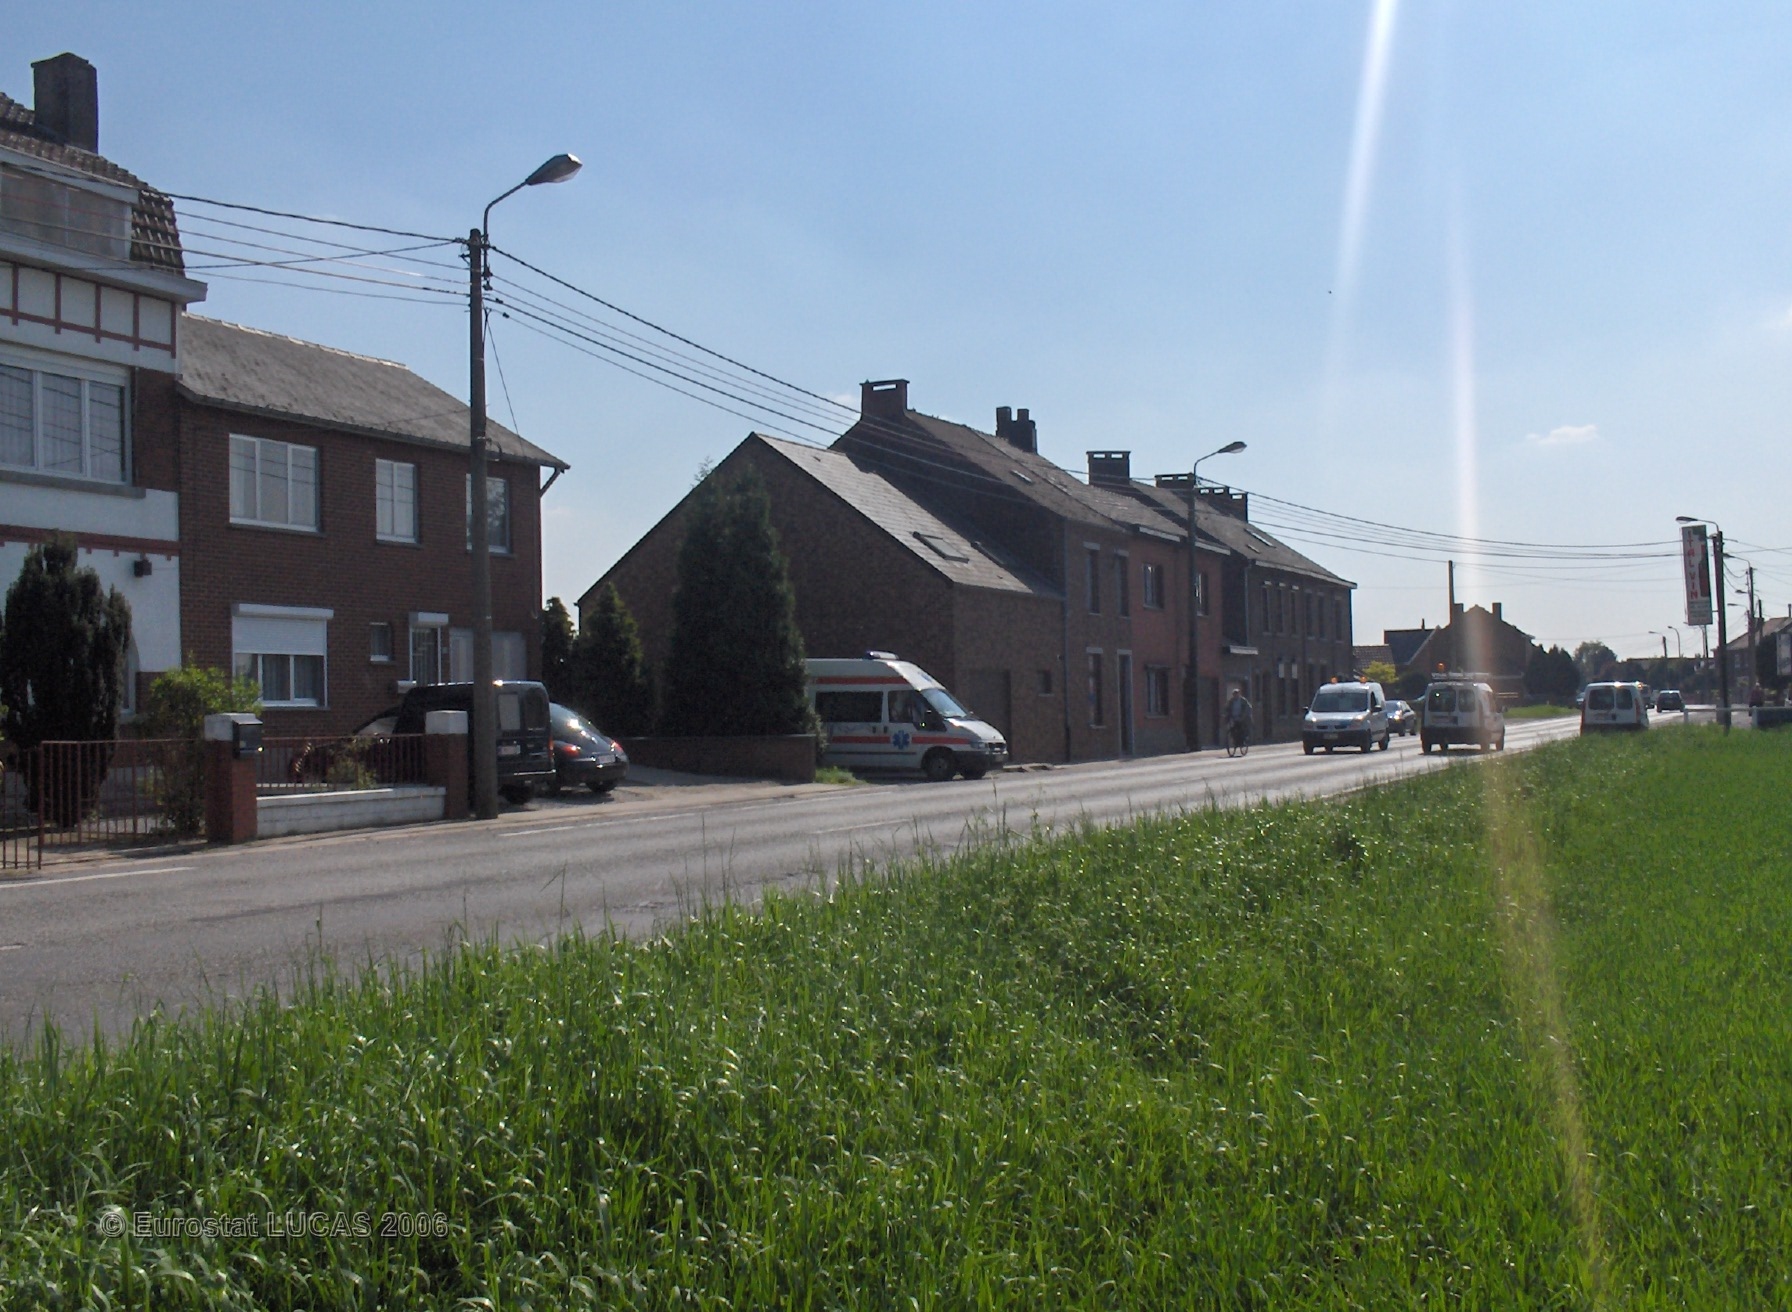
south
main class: Cropland
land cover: Common wheat
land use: Agriculture (excluding fallow land and kitchen gardens)
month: May
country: BE
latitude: 50.4502
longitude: 4.5457
